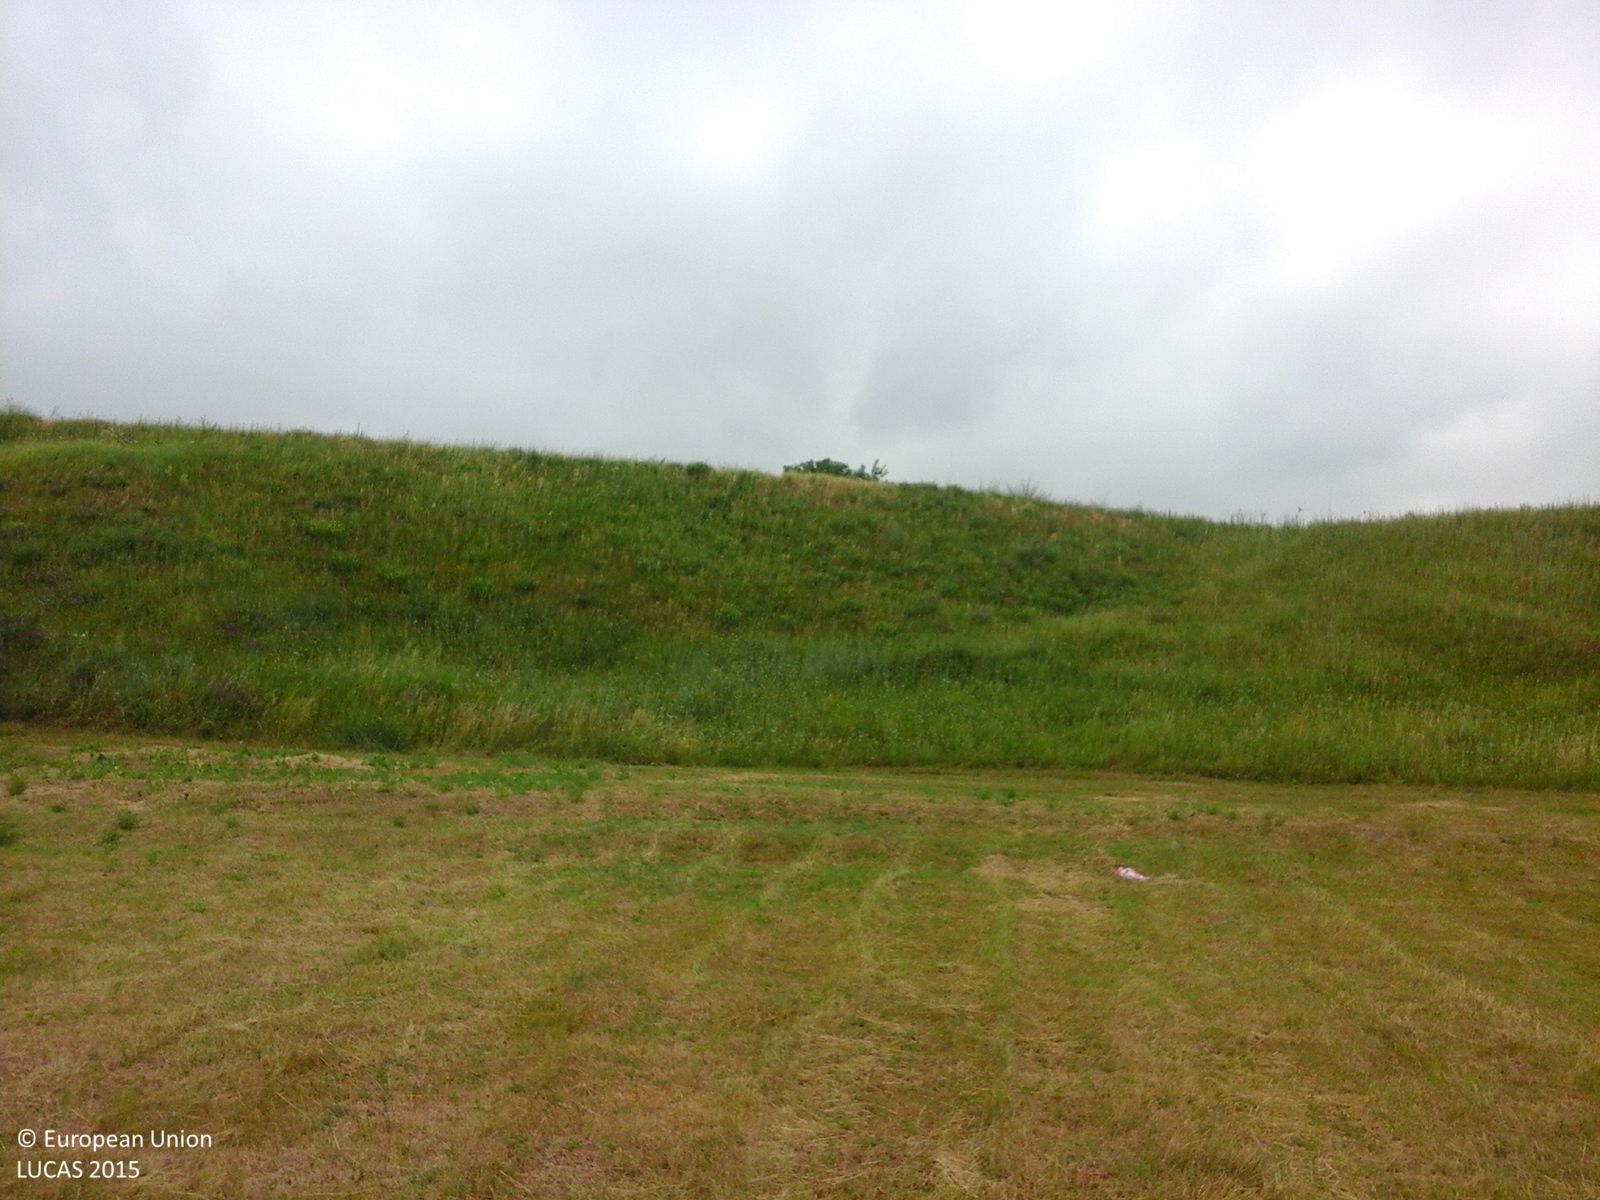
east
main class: Cropland
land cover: Other leguminous and mixtures for fodder
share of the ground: > 75 %
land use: Agriculture (excluding fallow land and kitchen gardens)
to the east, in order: Other leguminous and mixtures for fodder; Tracks; Grassland without tree/shrub cover; Maize; Grass margins; Maize; Artificial constructions in urban areas; Lines of trees; Grass margins; Dry pulses; Lucerne; Maize; Electric lines; Fences; Other fresh vegetables
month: June
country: RO
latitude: 47.3627
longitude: 26.6838
